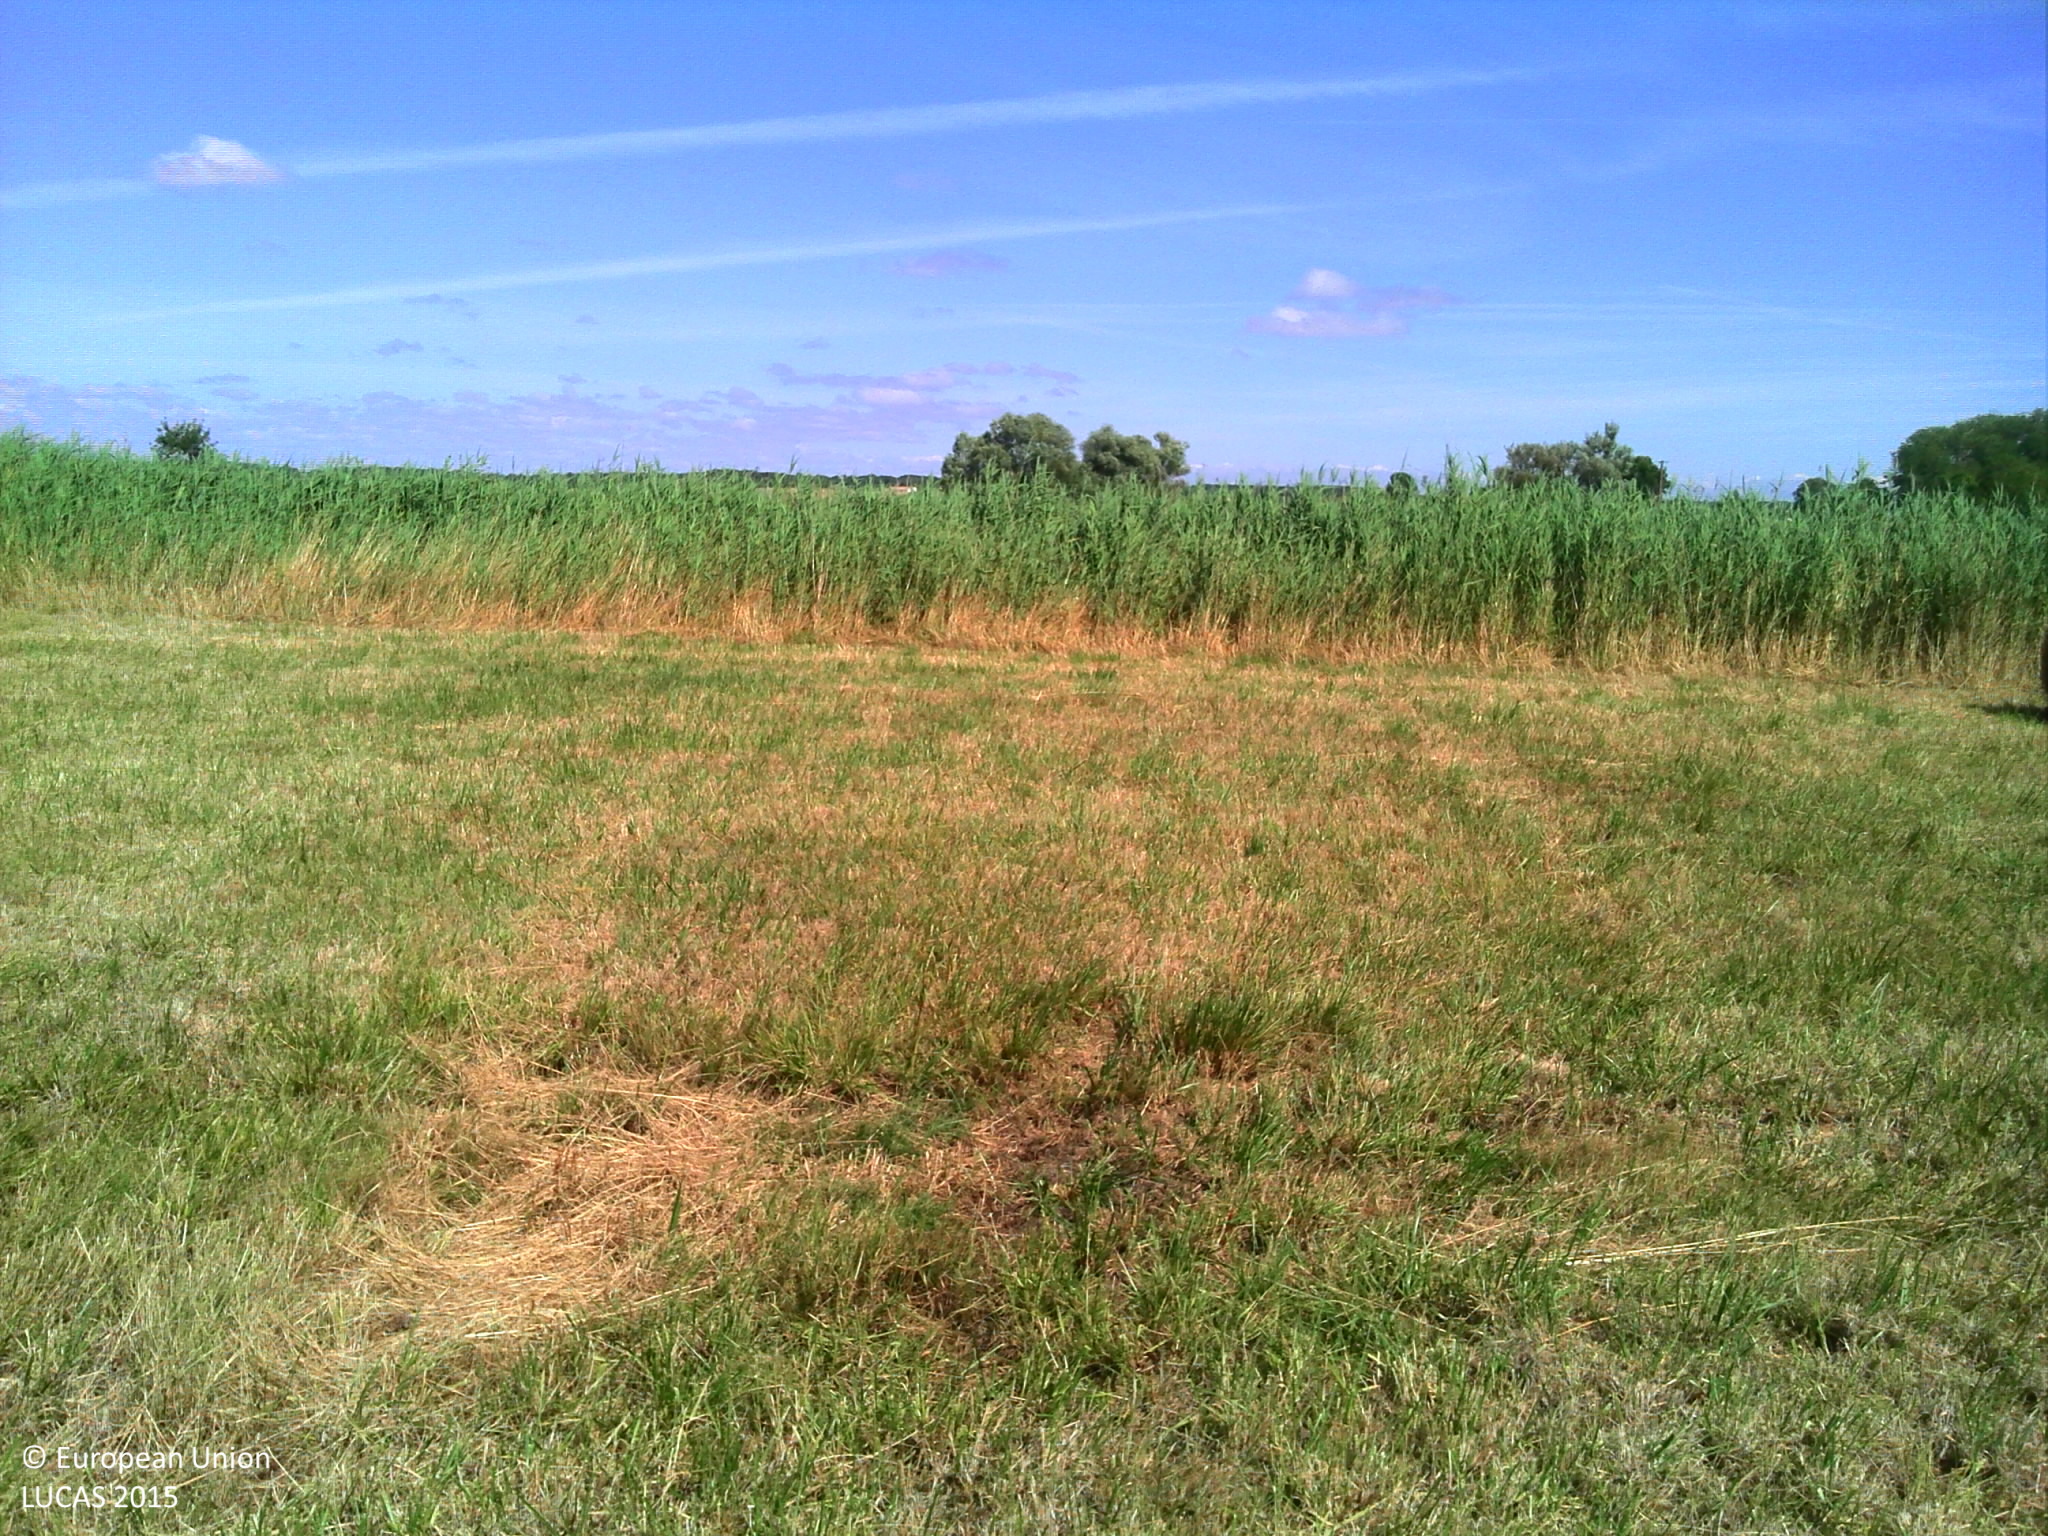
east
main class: Grassland
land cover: Grassland without tree/shrub cover
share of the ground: > 75 %
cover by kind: herbaceous plants 100 %
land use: Agriculture (excluding fallow land and kitchen gardens)
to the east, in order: Grassland without tree/shrub cover; Ditches and canals; Fences; Grassland without tree/shrub cover; Fences; Ditches and canals; Grass margins; Paved roads, cycling and walking lanes; Grass margins; Ditches and canals; Fences; Grassland without tree/shrub cover
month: June
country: FR
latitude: 45.6976
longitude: -1.1122
